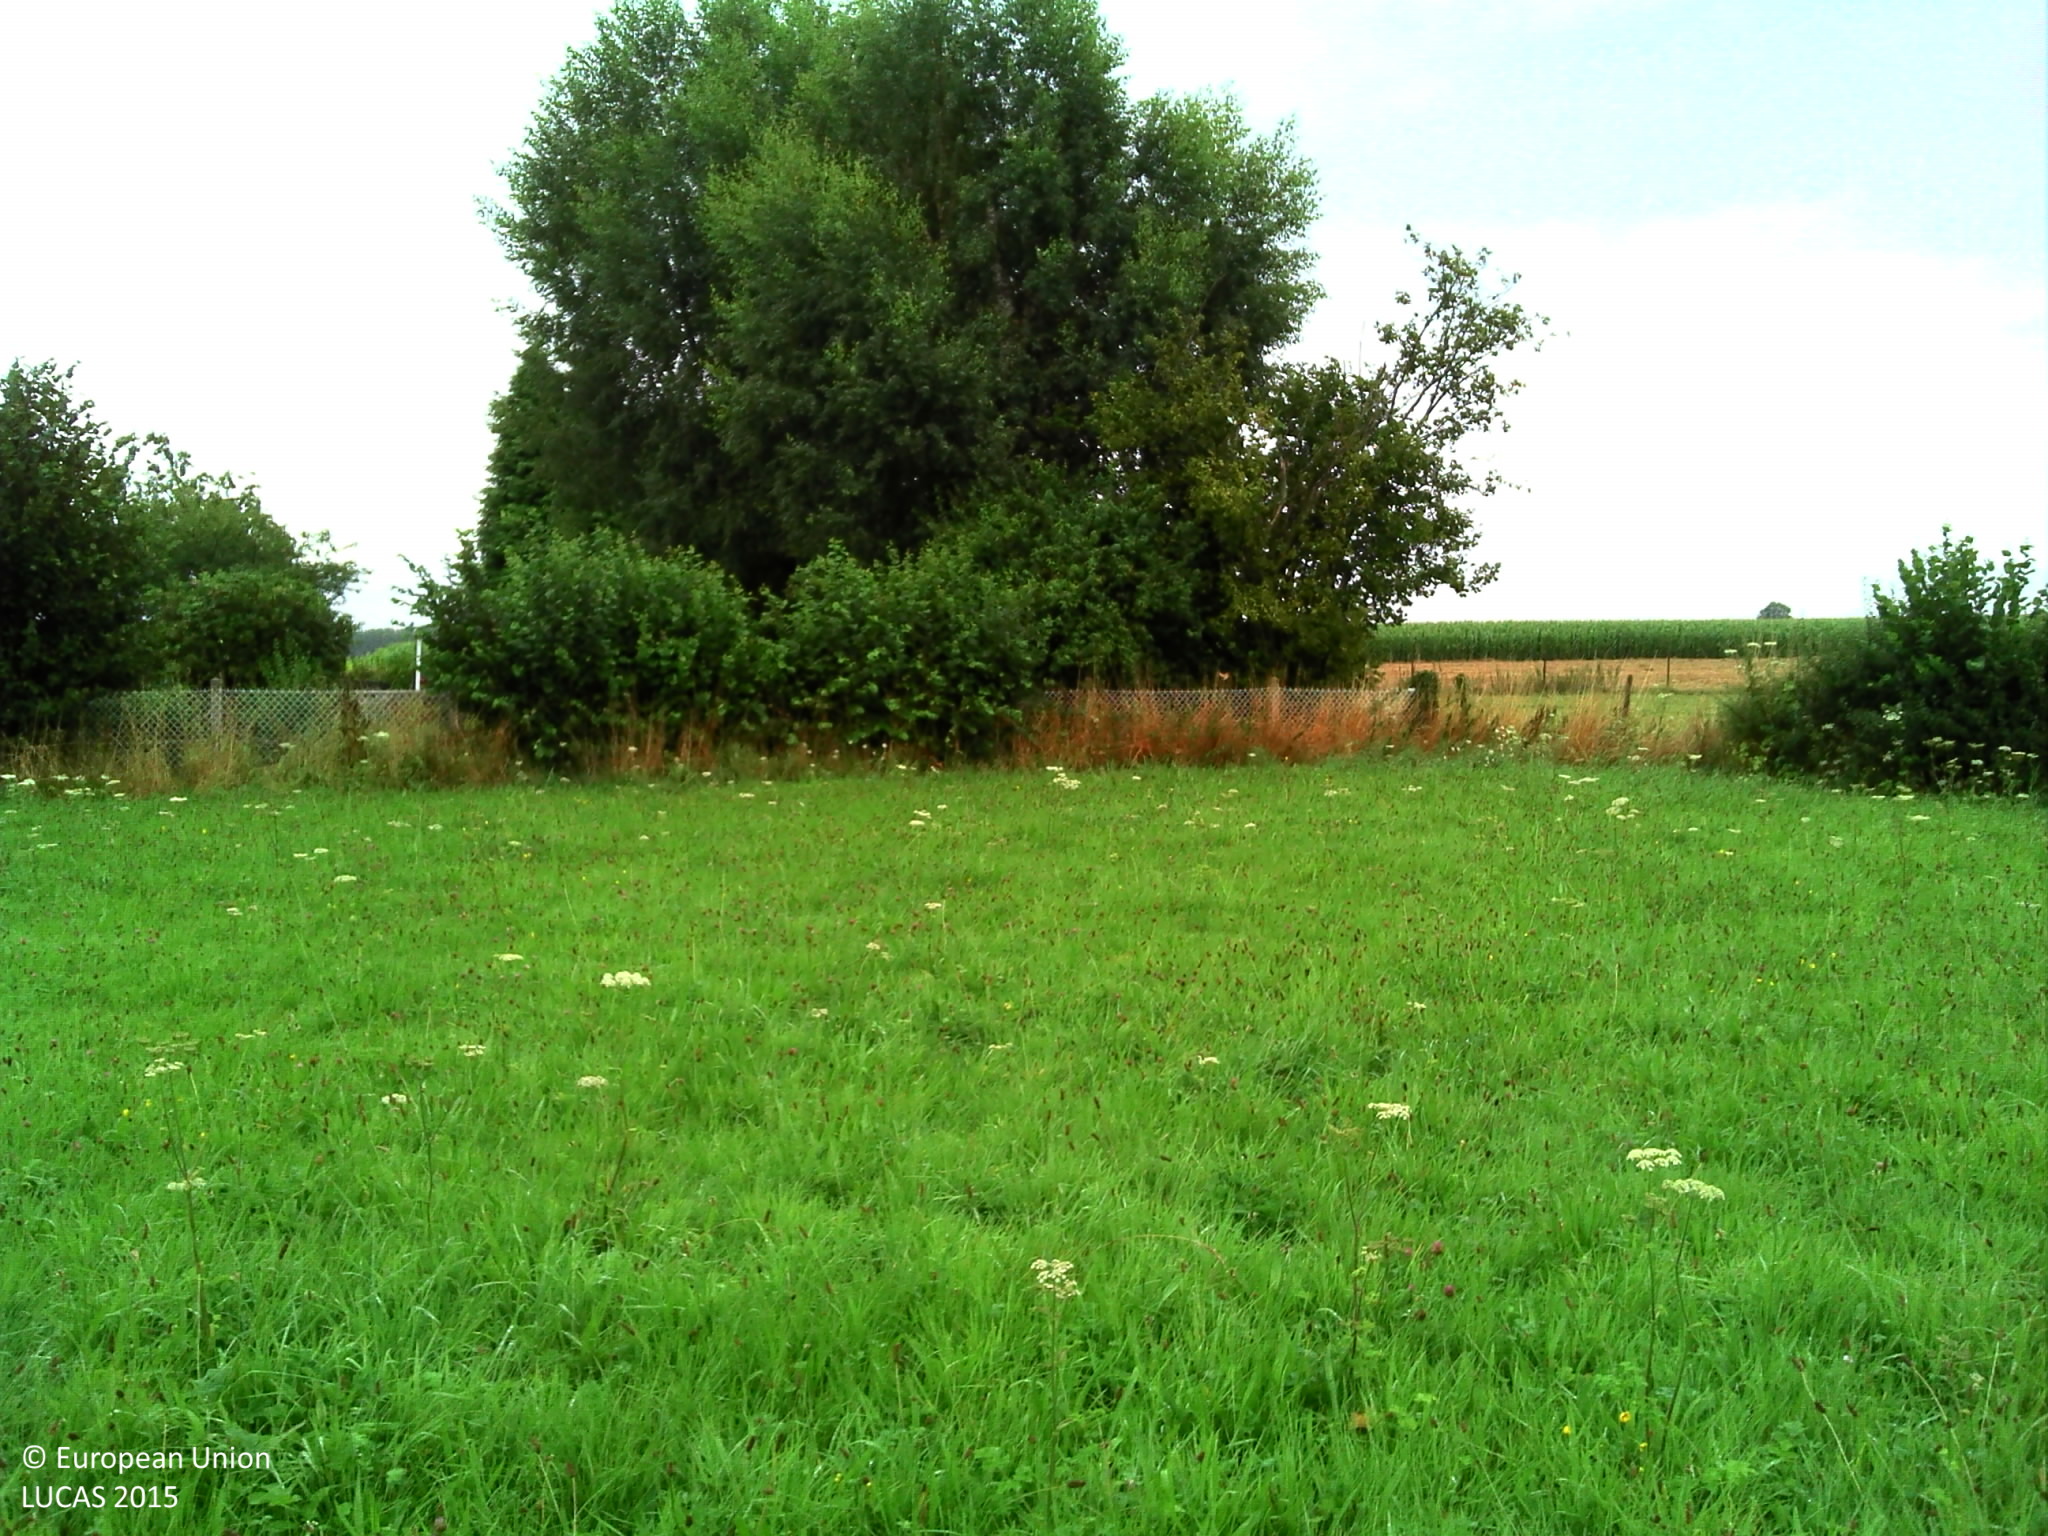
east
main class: Grassland
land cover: Grassland without tree/shrub cover
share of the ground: > 75 %
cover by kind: herbaceous plants 100 %
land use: Agriculture (excluding fallow land and kitchen gardens)
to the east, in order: Grassland without tree/shrub cover; Fences; Managed hedges; Grassland with sparse tree/shrub cover; Managed hedges; Fences; Grassland without tree/shrub cover; Fences; Grass margins; Dry pulses; Maize
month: August
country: FR
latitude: 50.2653
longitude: 4.0885
